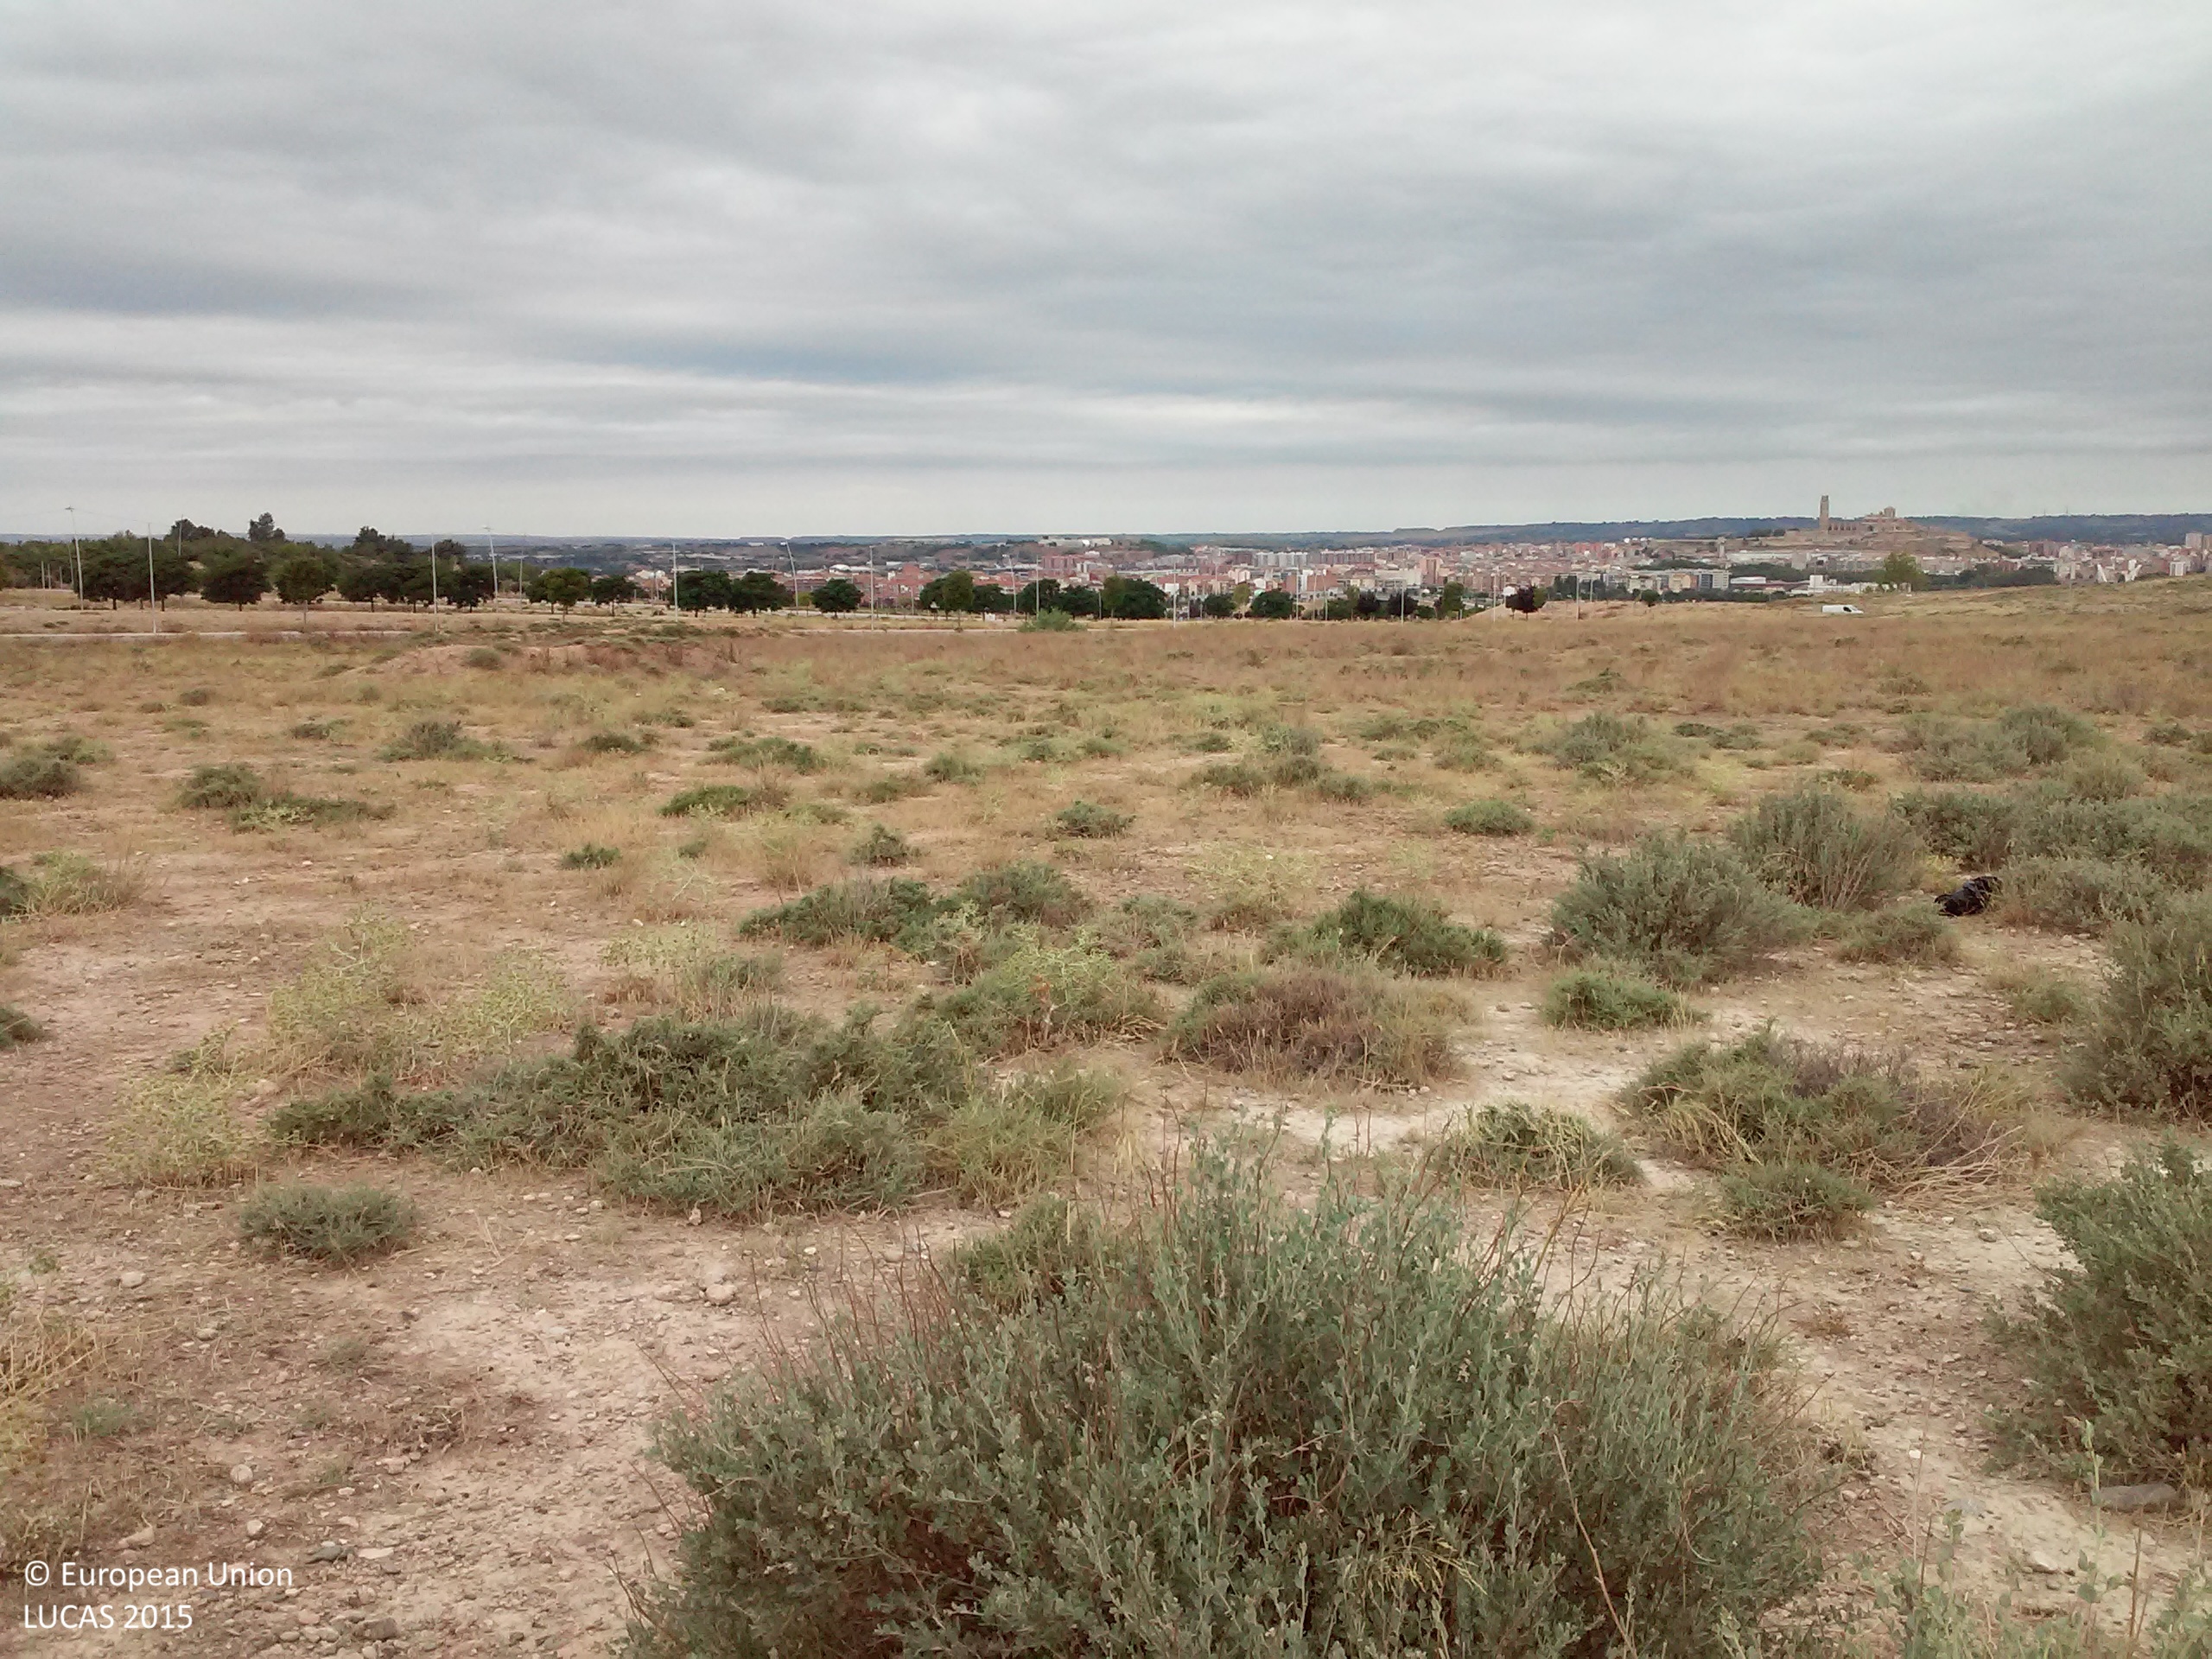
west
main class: Grassland
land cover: Grassland without tree/shrub cover
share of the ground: > 75 %
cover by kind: herbaceous plants 60 %, consolidated bare surface 35 %, shrubs 5 %
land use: Residential
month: July
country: ES
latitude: 41.6041
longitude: 0.6650
